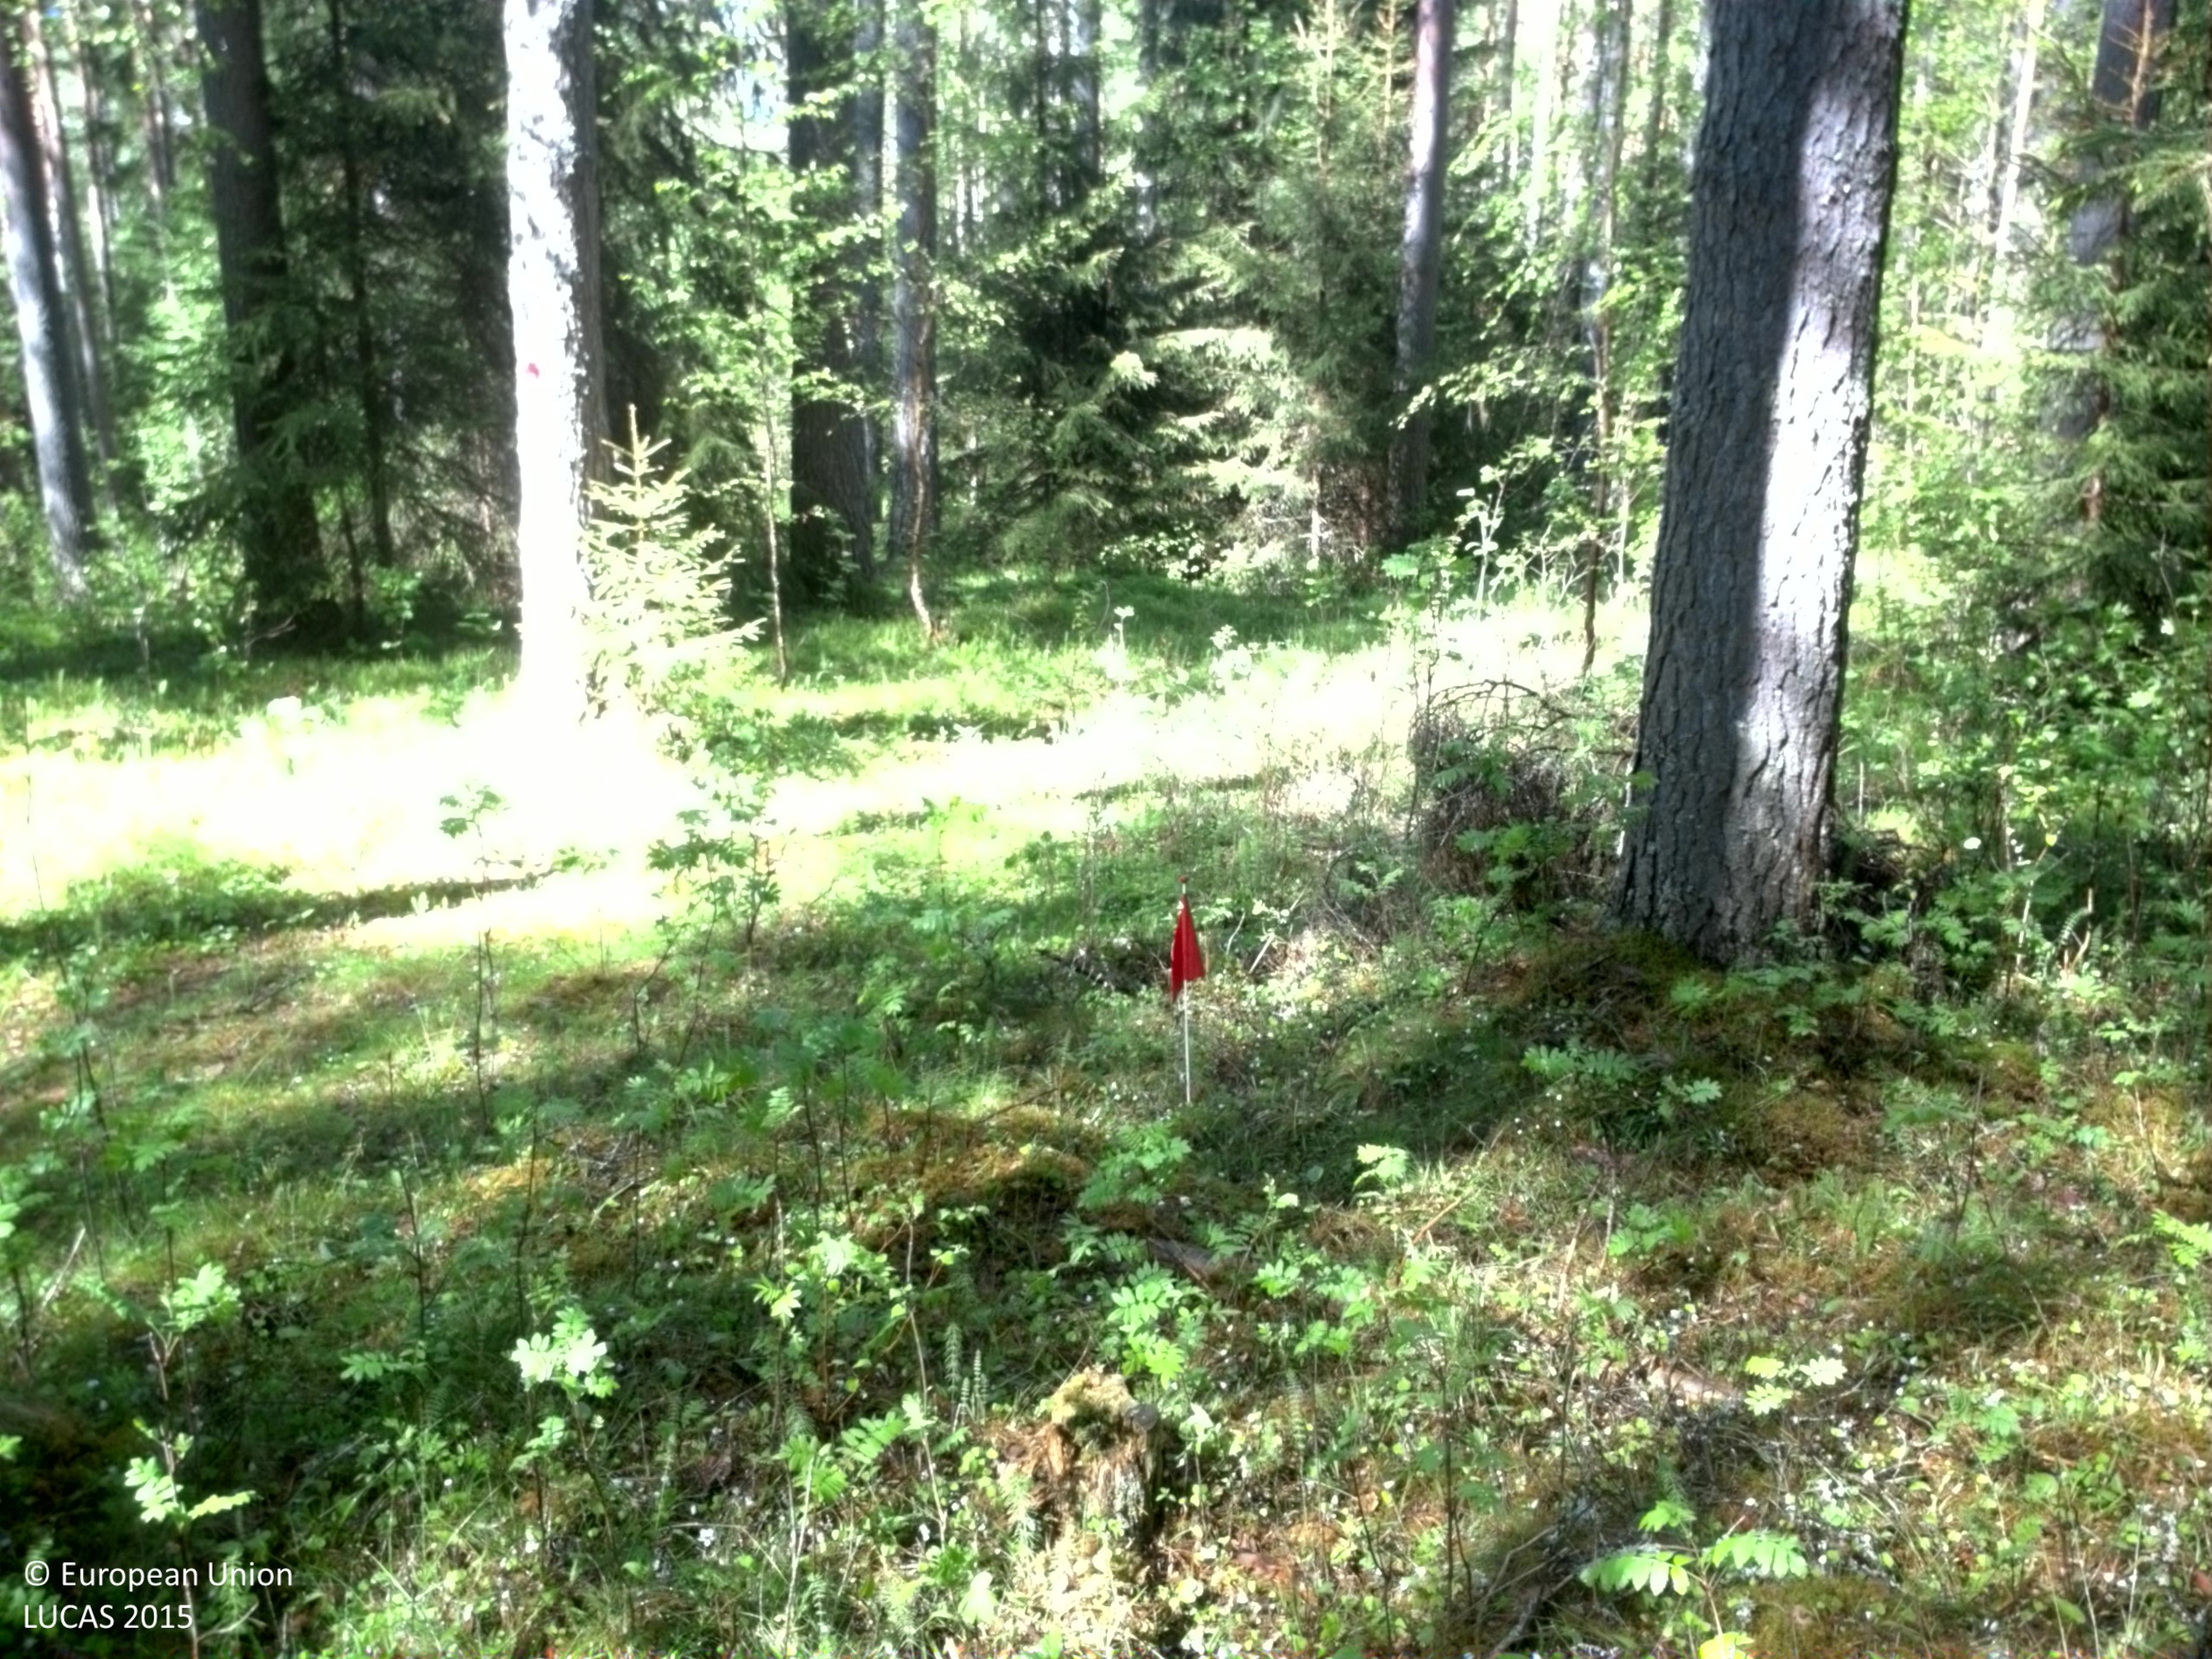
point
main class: Woodland
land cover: Pine dominated mixed woodland
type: boreal forest
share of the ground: 50 - 75 %
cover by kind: coniferous forest trees 40 %, broadleaved forest trees 20 %, shrubs 20 %, herbaceous plants 20 %
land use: Forestry
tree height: > 5 m
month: June
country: SE
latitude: 63.1563
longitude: 17.3800
